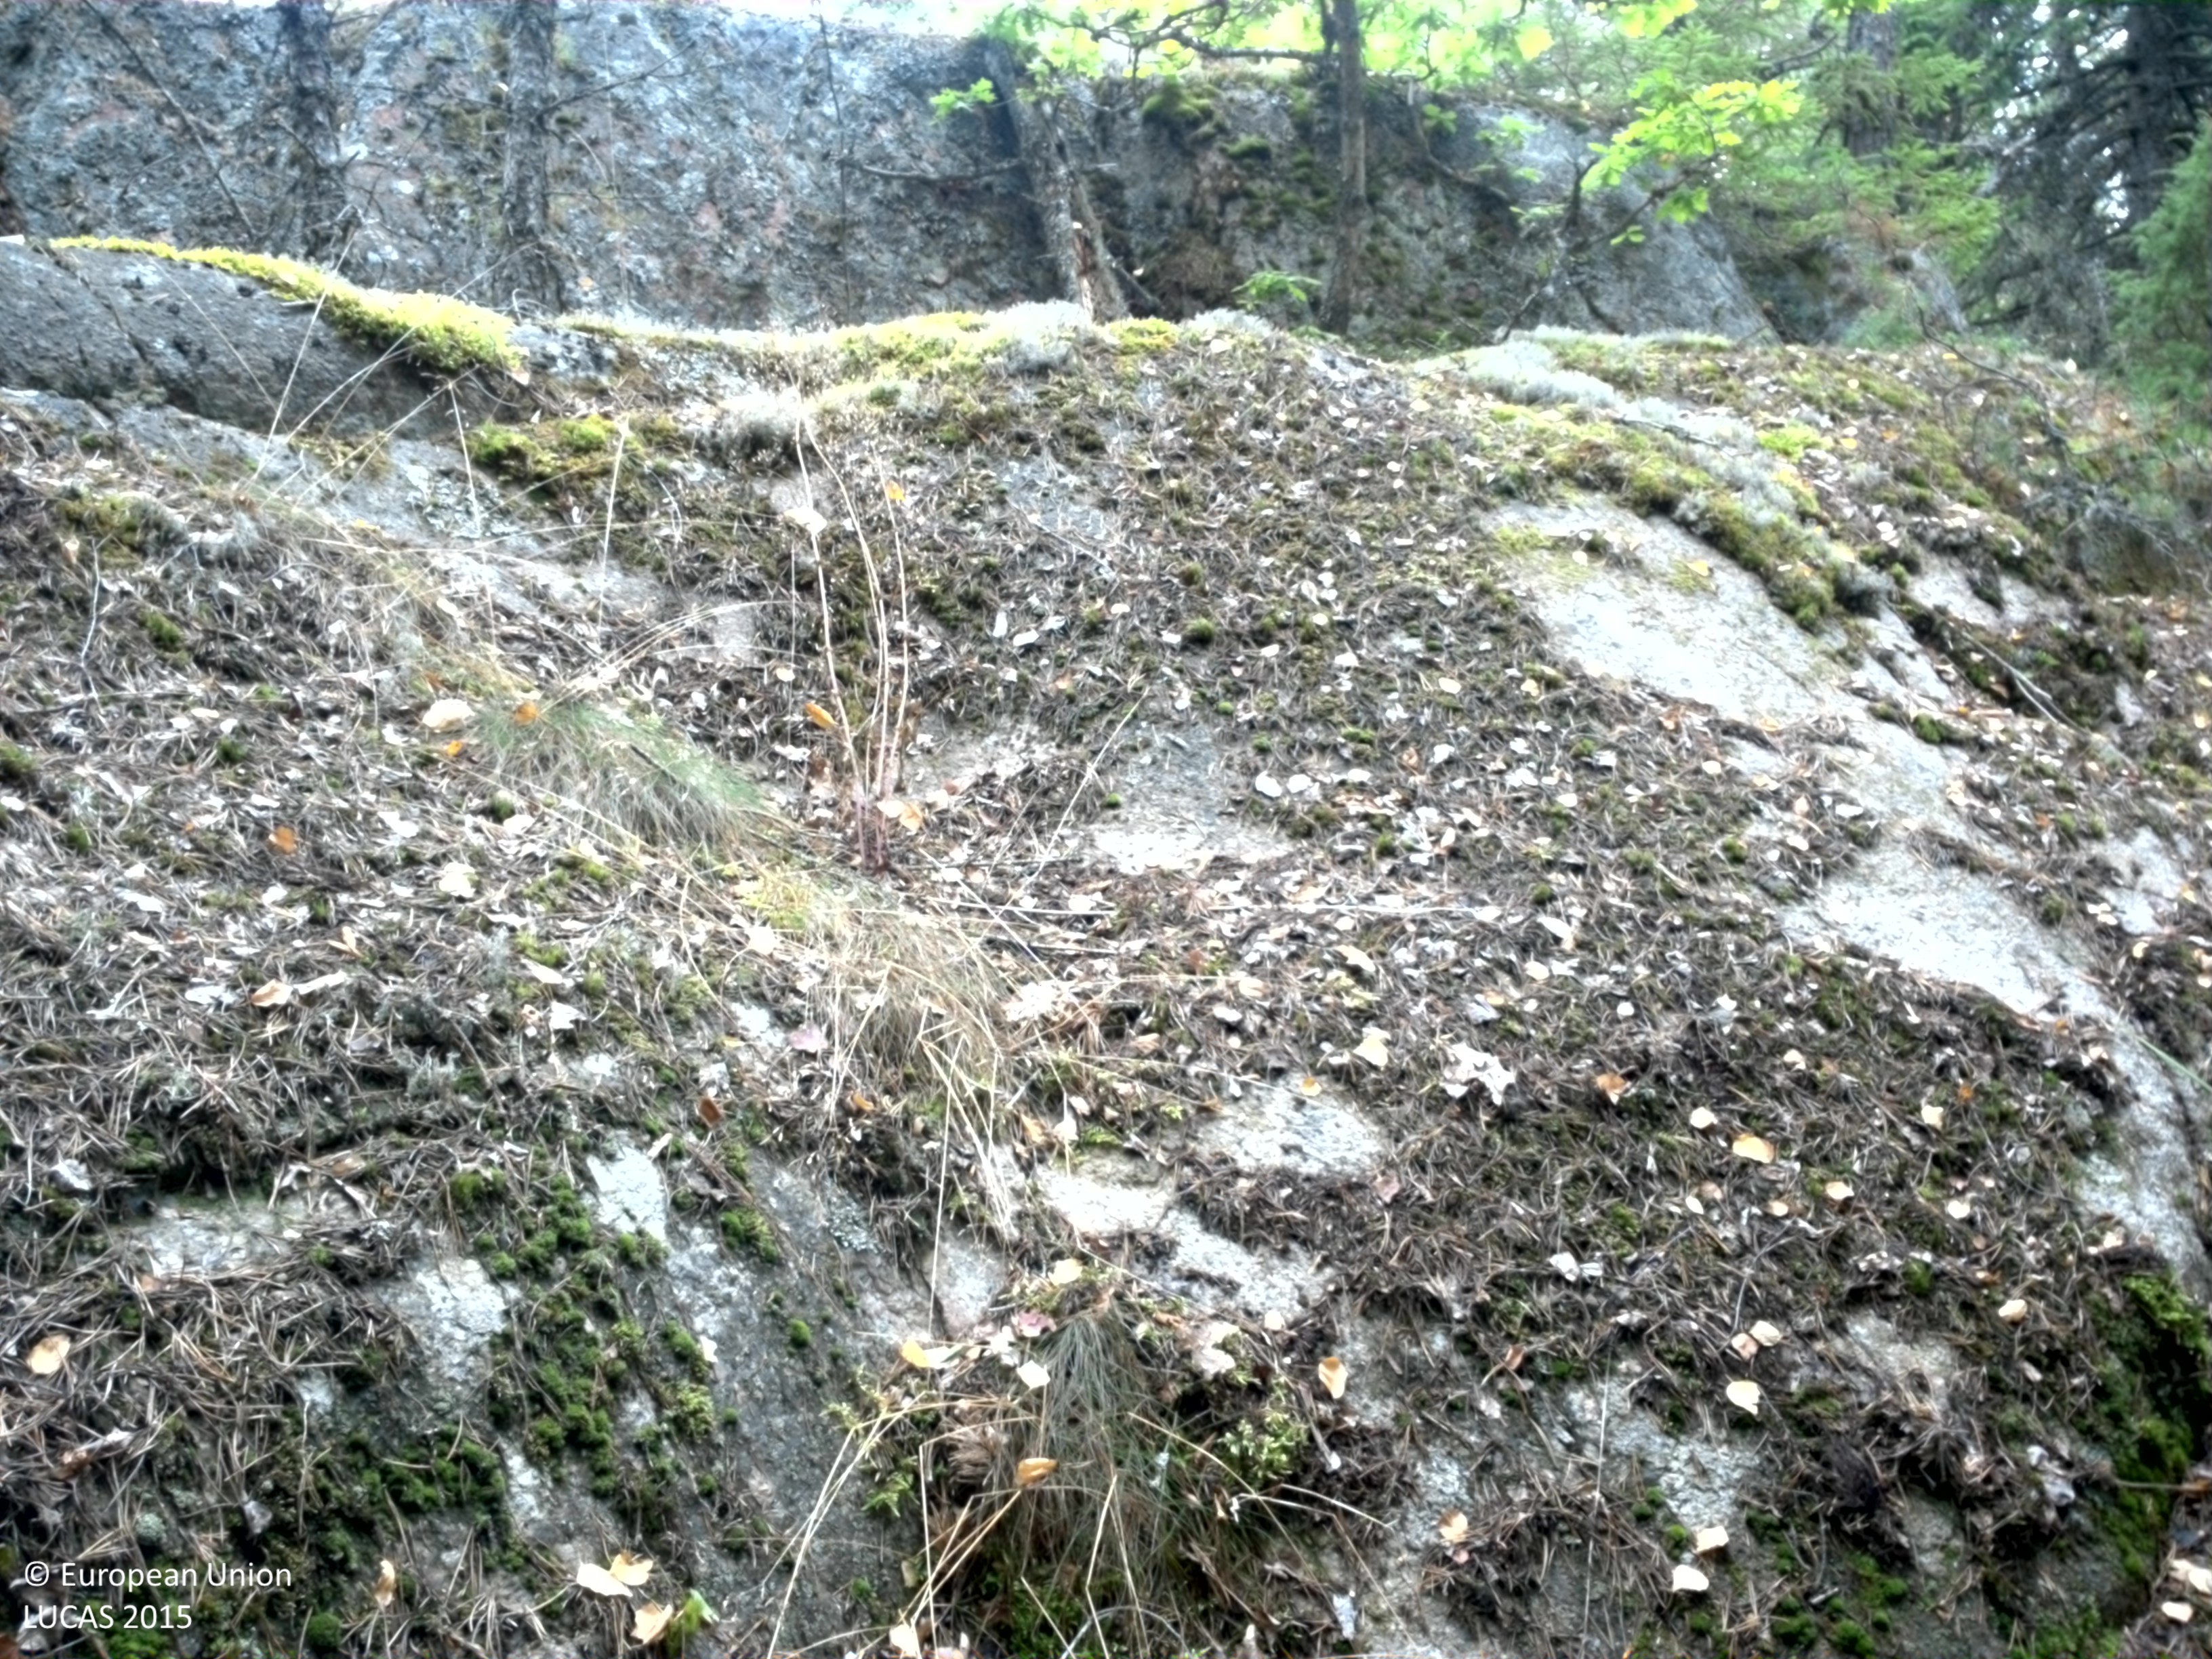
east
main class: Woodland
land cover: Pine dominated coniferous woodland
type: boreal forest
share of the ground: > 75 %
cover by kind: coniferous forest trees 75 %, herbaceous plants 10 %, lichens and mosses 10 %, broadleaved forest trees 5 %
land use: Forestry
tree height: > 5 m
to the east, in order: Pine dominated coniferous woodland; Pine dominated mixed woodland; Pine dominated coniferous woodland; Spruce dominated mixed woodland
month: August
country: SE
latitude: 59.9118
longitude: 17.7736
